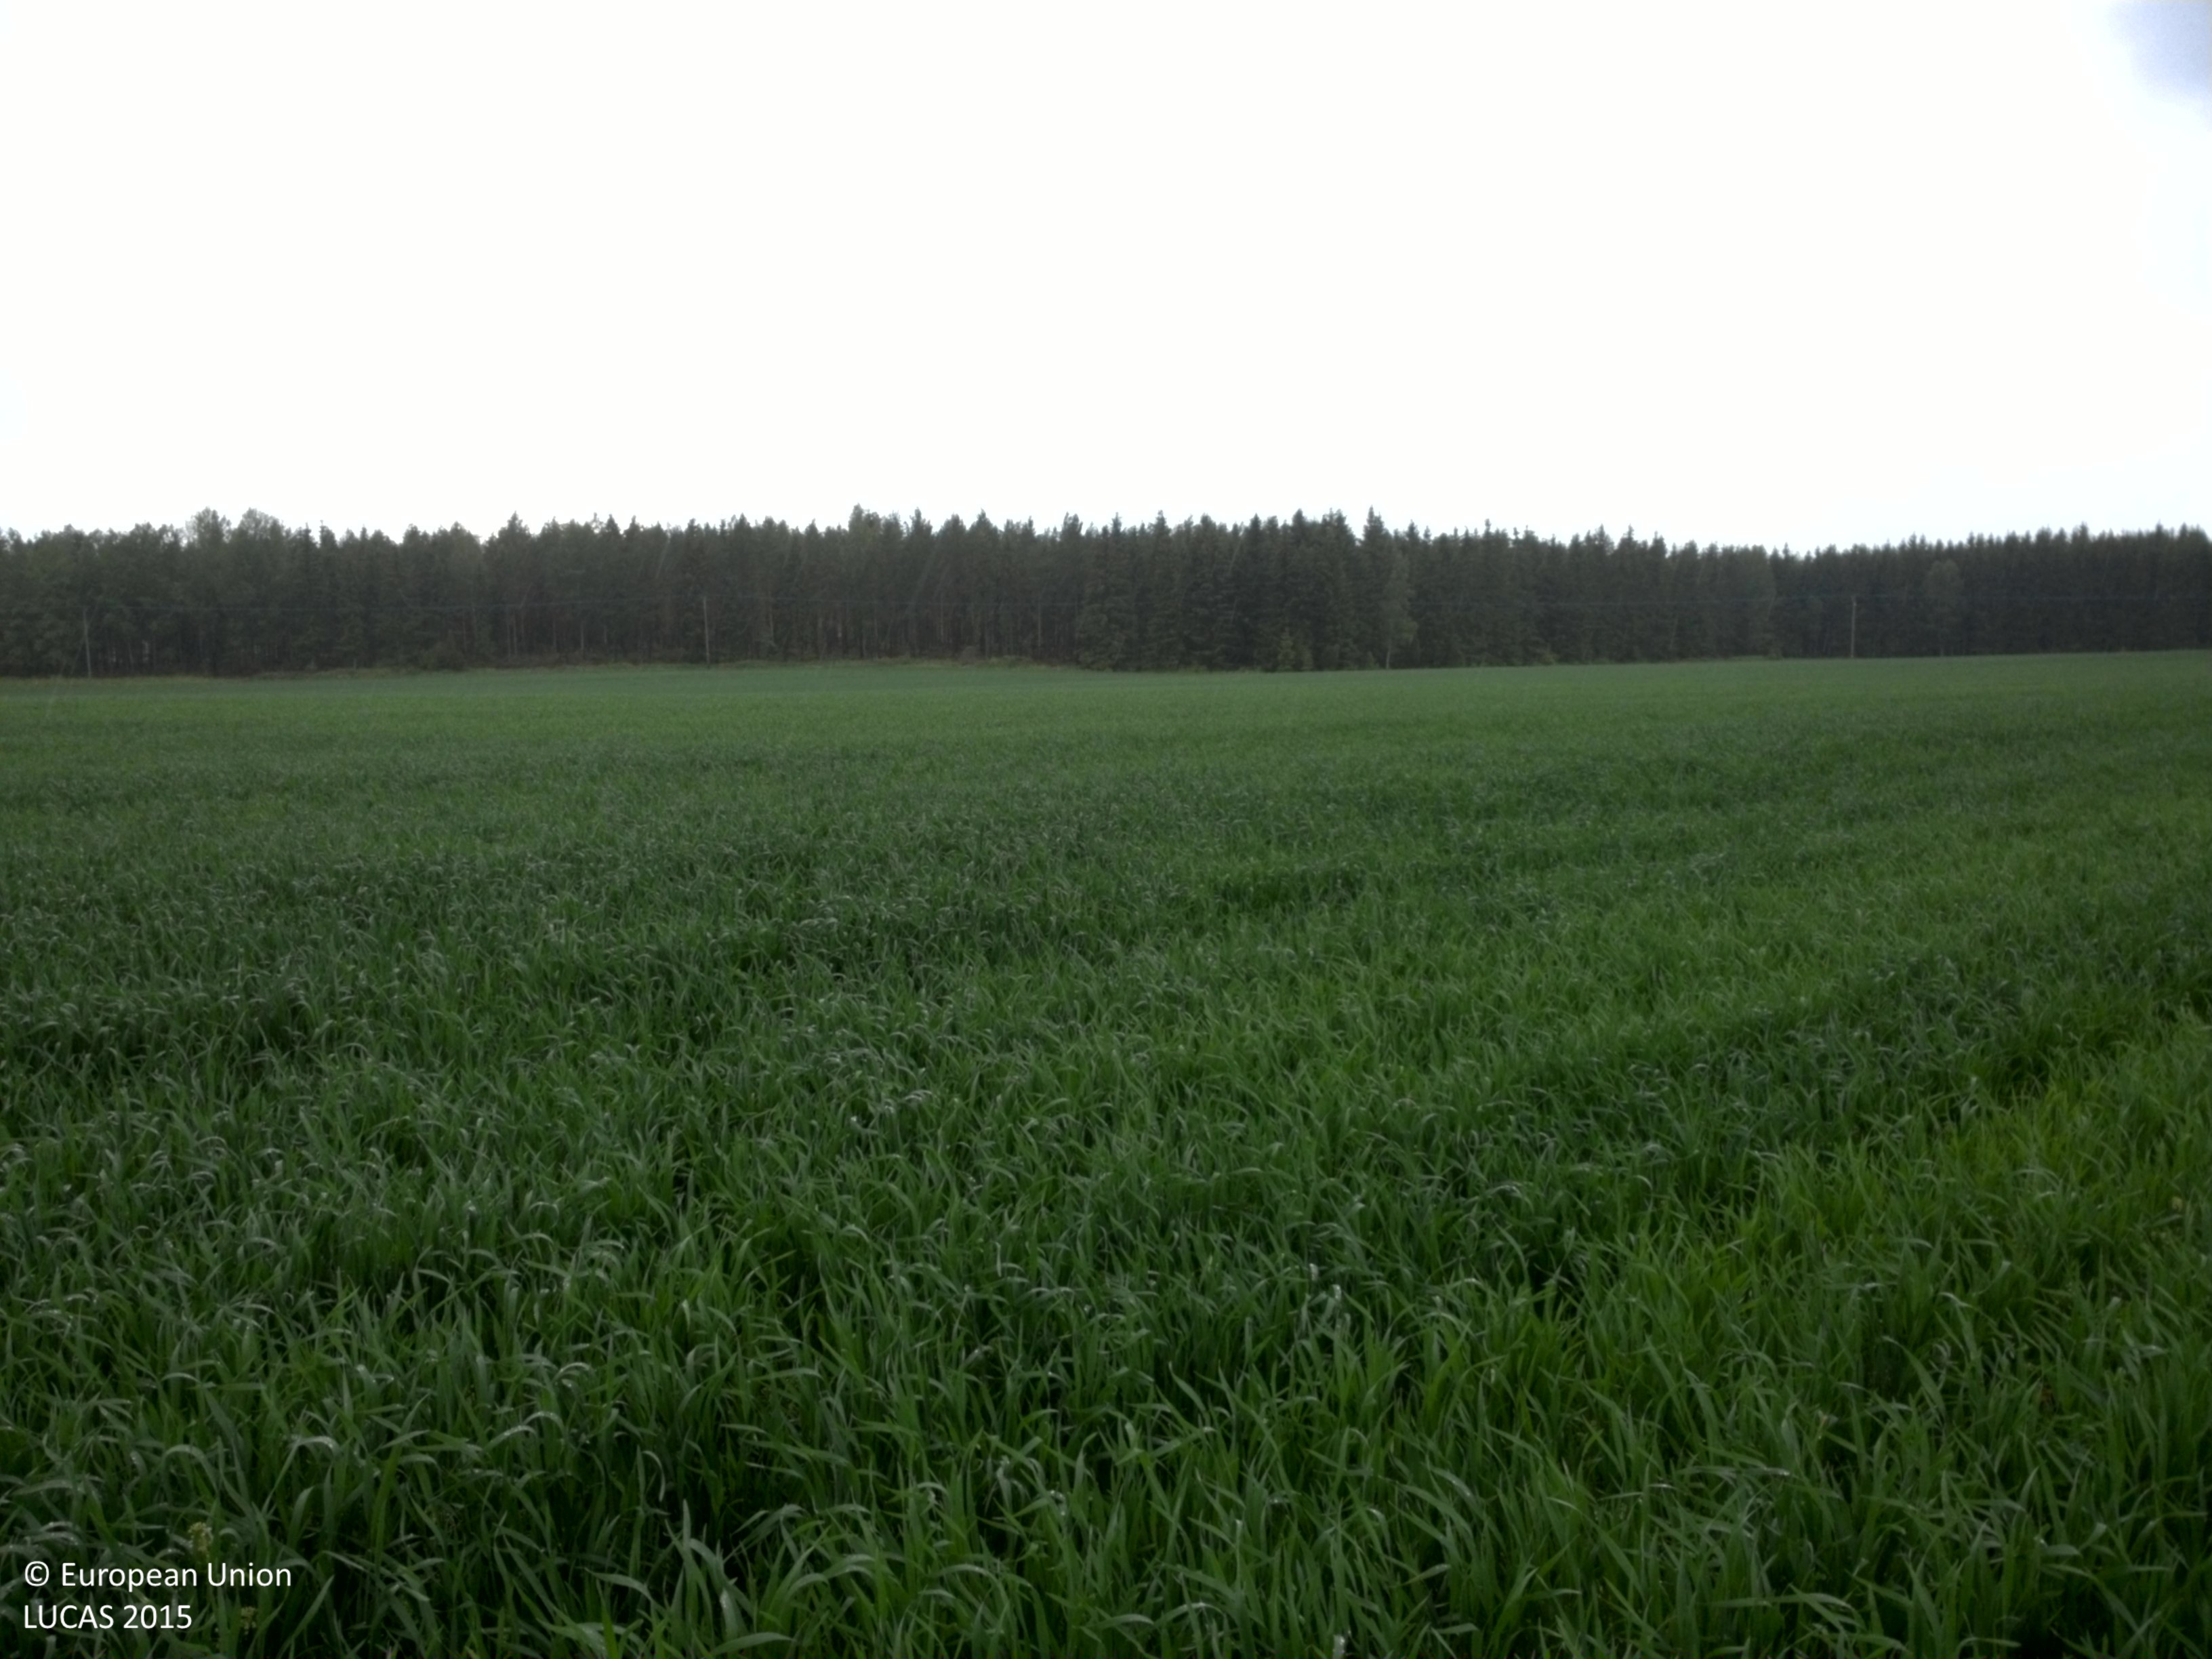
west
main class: Cropland
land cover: Oats
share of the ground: 50 - 75 %
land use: Agriculture (excluding fallow land and kitchen gardens)
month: June
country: SE
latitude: 59.8206
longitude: 17.1084
